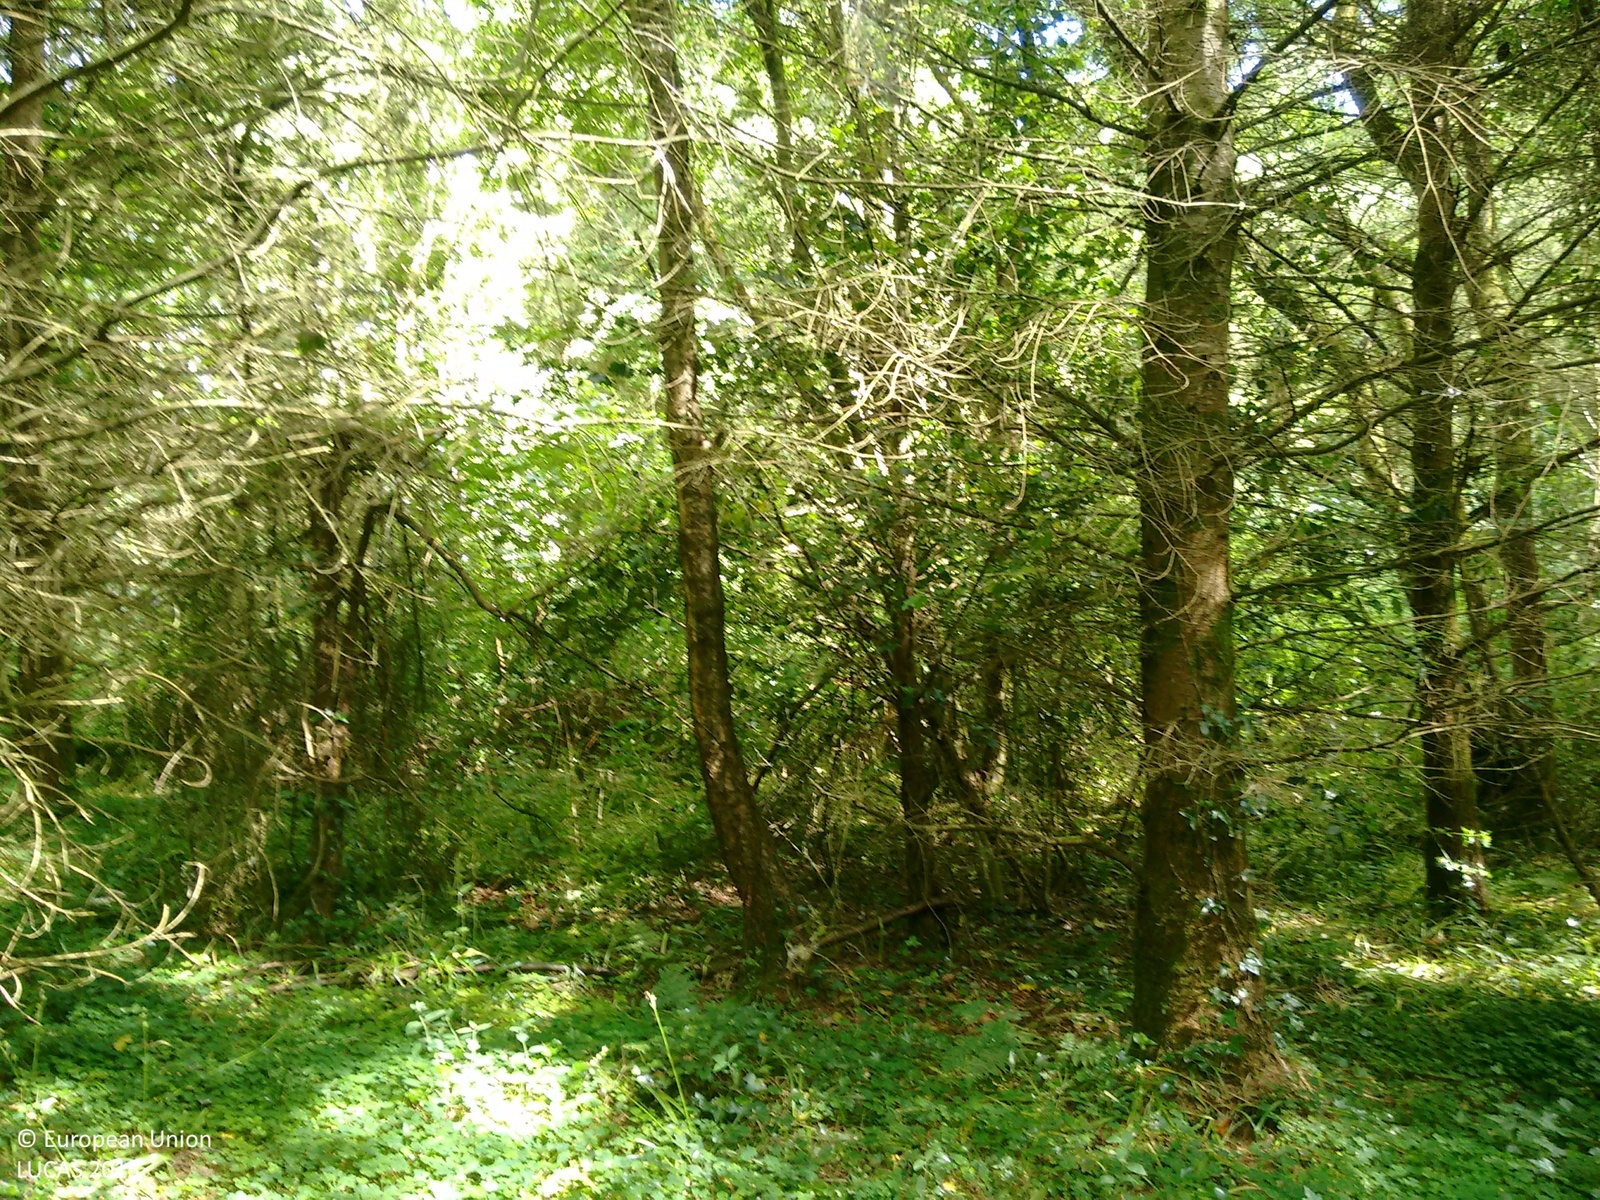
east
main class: Woodland
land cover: Spruce dominated mixed woodland
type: boreal forest
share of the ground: > 75 %
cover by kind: coniferous forest trees 60 %, broadleaved forest trees 30 %, shrubs 10 %
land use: Forestry
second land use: Amenities, museums, leisure
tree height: > 5 m
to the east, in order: Spruce dominated mixed woodland; Tracks; Grass margins; Spruce dominated mixed woodland
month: June
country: IE
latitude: 53.4286
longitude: -7.8229
